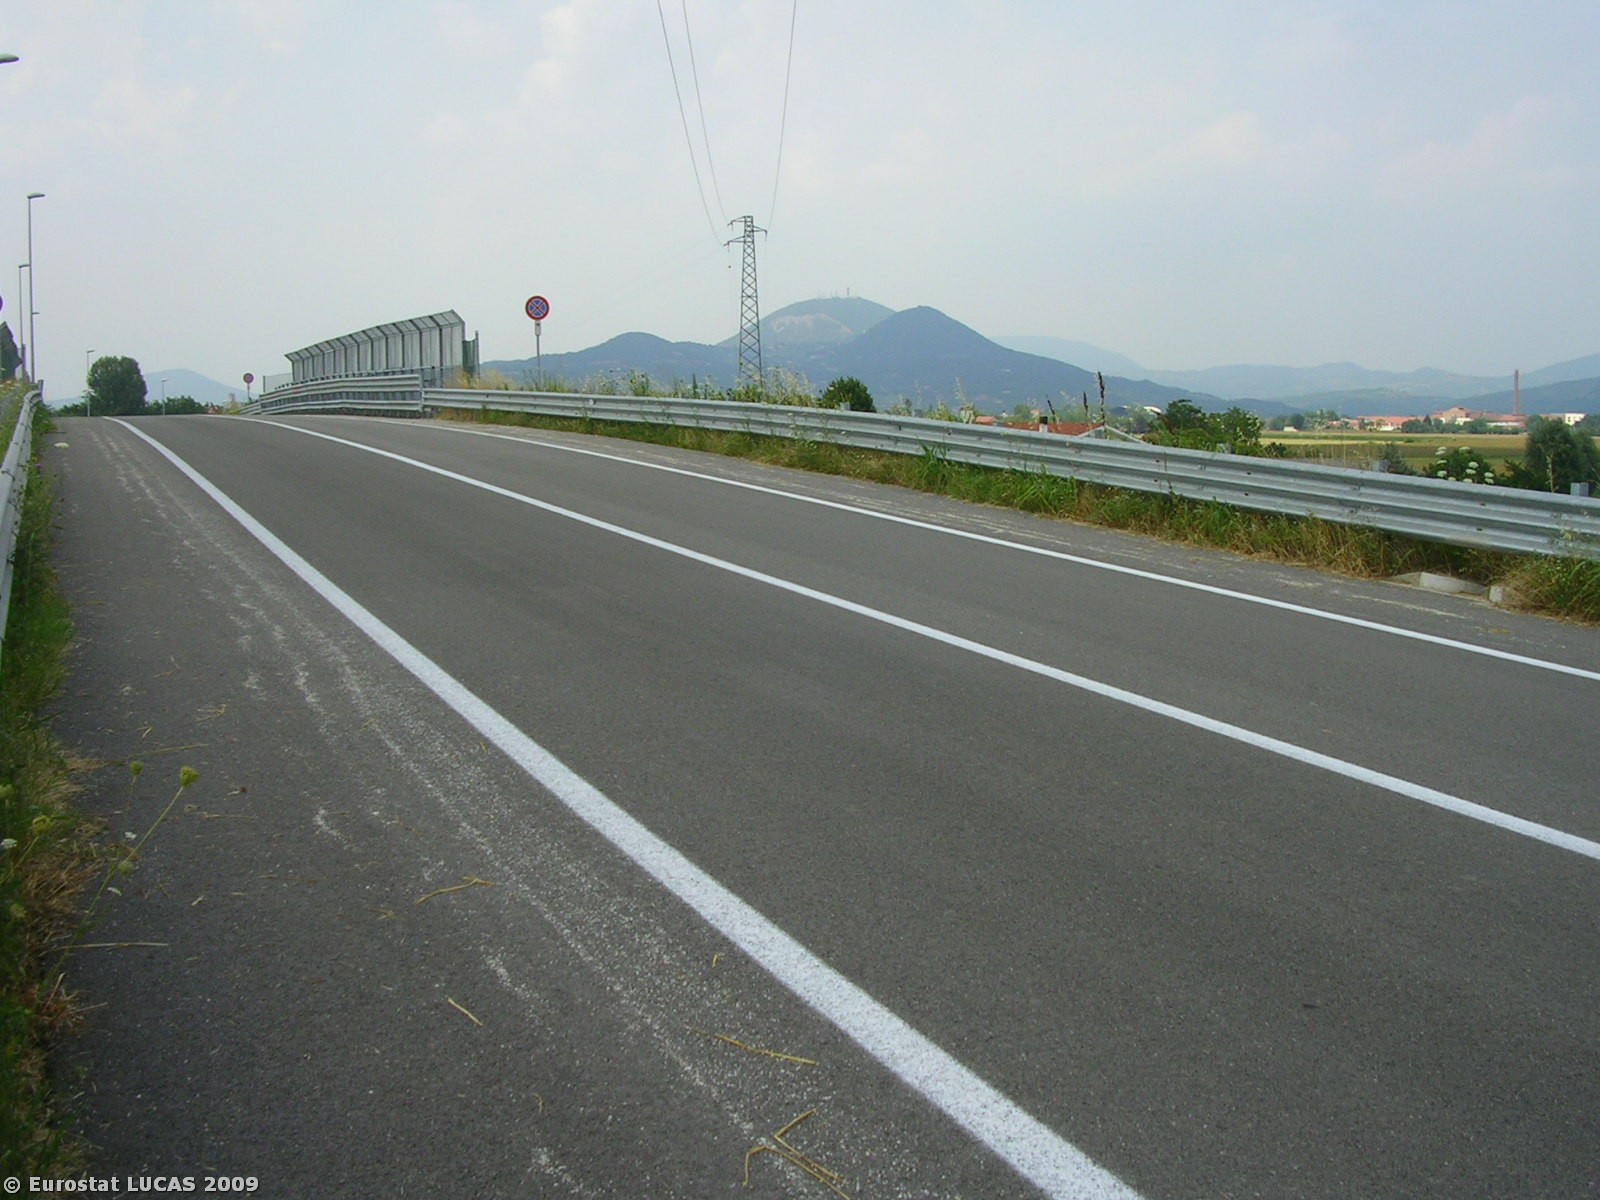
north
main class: Cropland
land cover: Common wheat
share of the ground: > 75 %
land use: Agriculture (excluding fallow land and kitchen gardens)
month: July
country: IT
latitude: 45.2028
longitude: 11.6648
